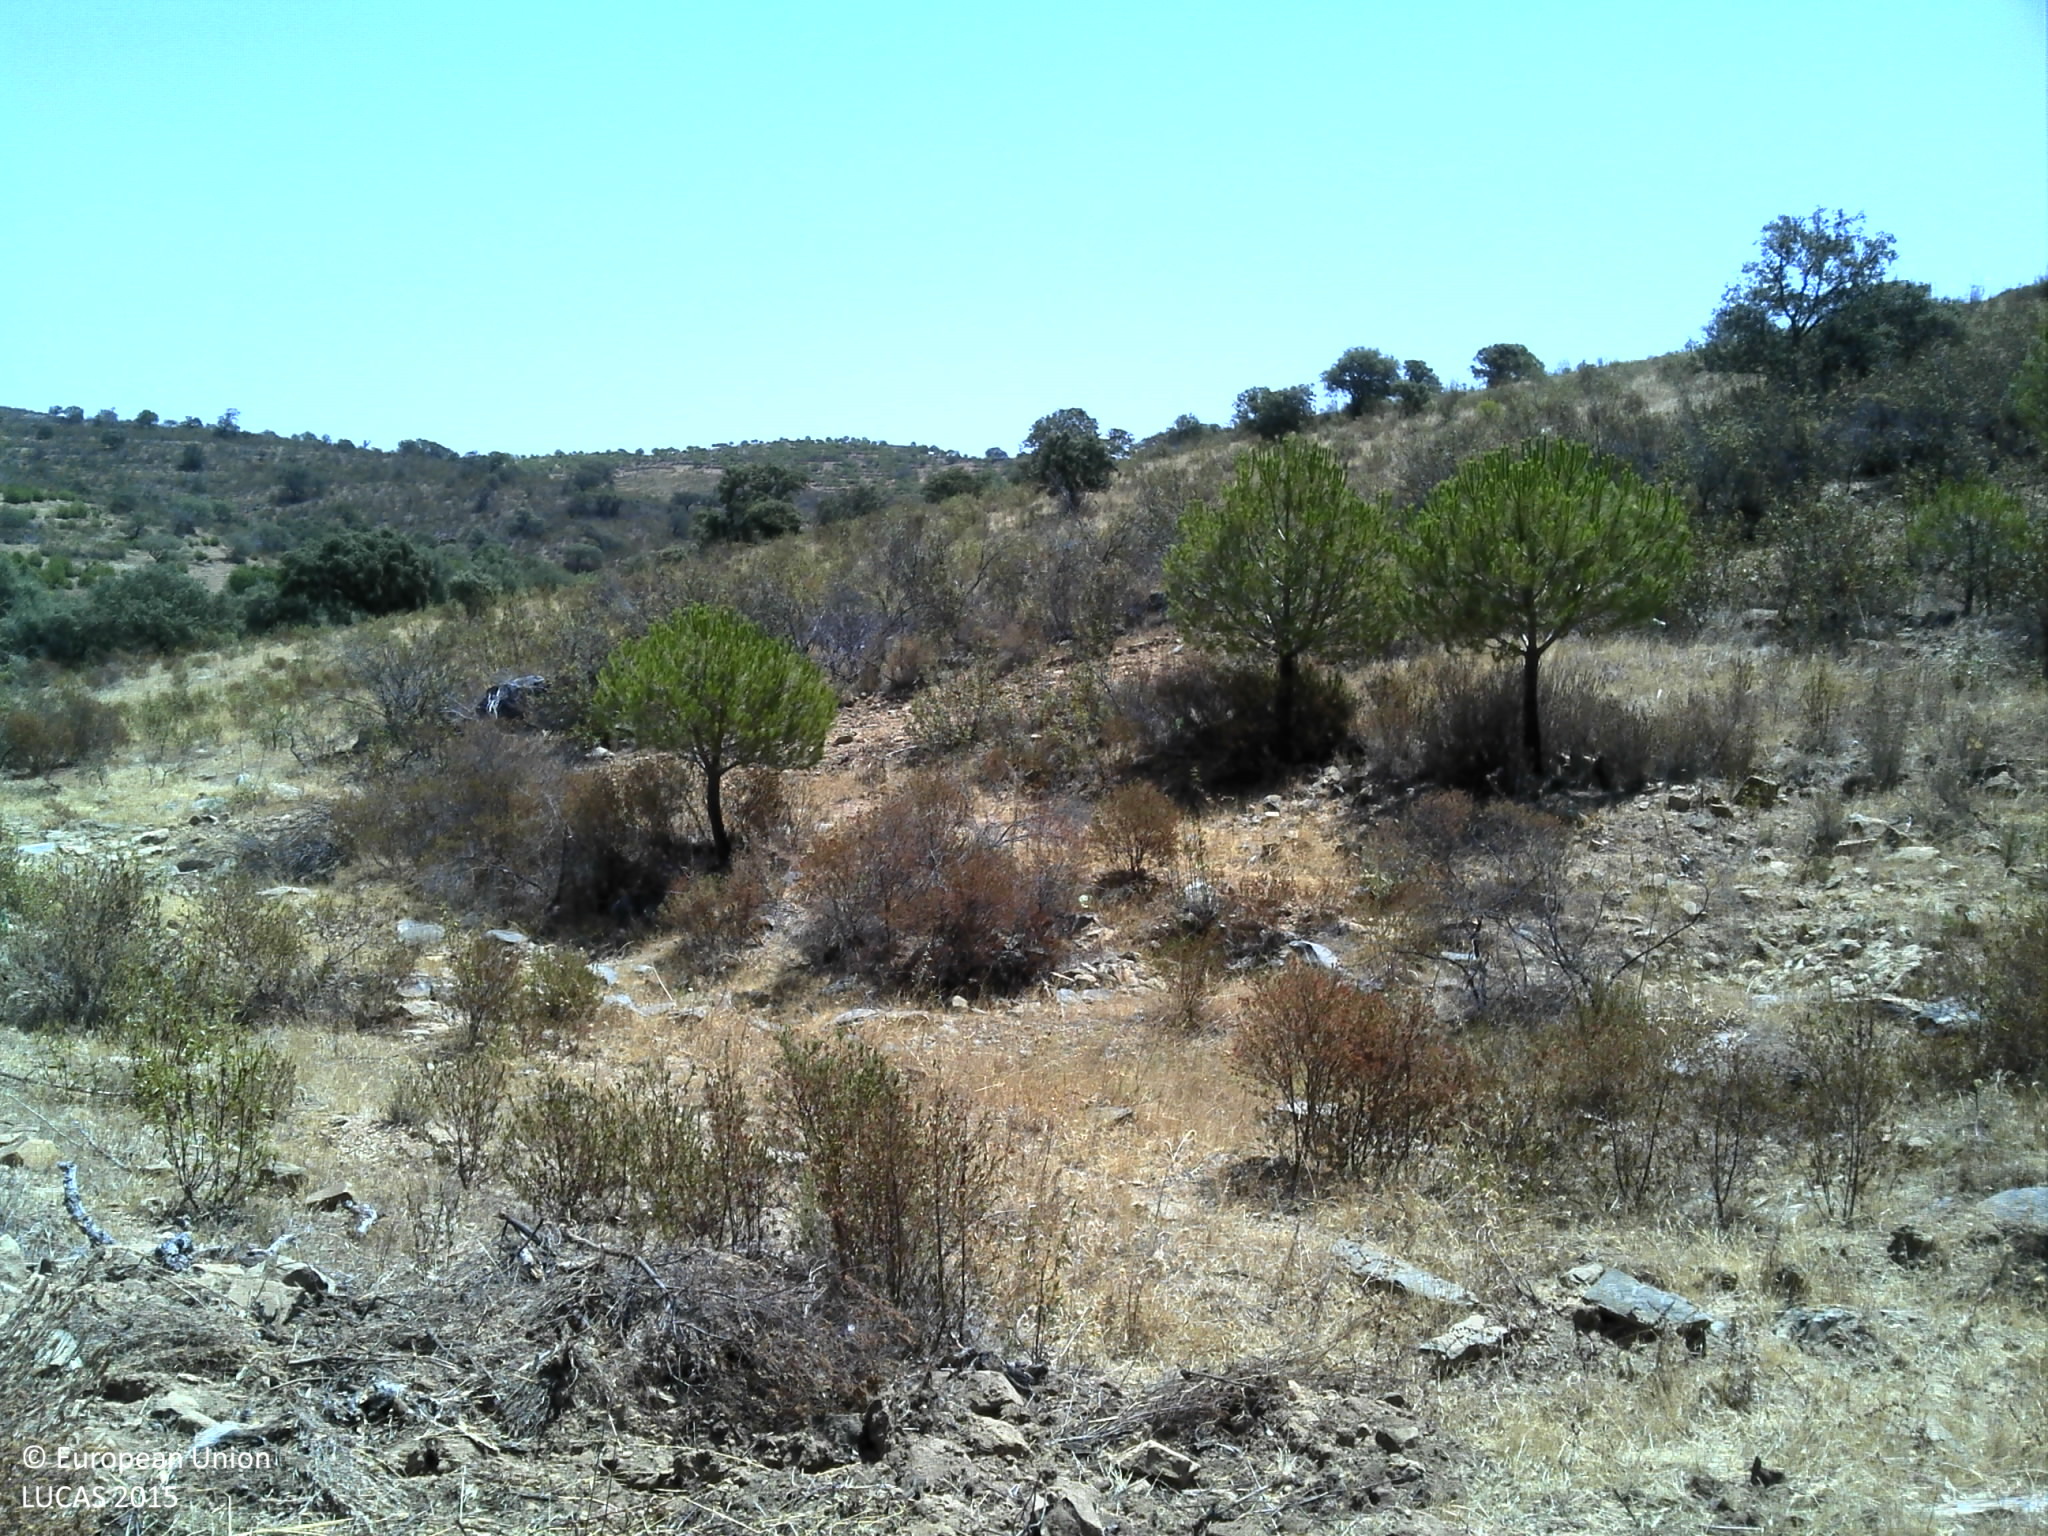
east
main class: Woodland
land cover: Pine dominated coniferous woodland
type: coniferous forest of the mediterranean region
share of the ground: 10 - 25 %
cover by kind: unconsolidated bare surface 55 %, coniferous forest trees 20 %, shrubs 20 %, herbaceous plants 5 %
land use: Forestry
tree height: < 5 m
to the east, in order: Pine dominated coniferous woodland; Rivers and streams; Pine dominated coniferous woodland; Other structural elements; Rock outcrops; Shrubland without tree cover; Single bushes/trees; Shrubland without tree cover; Single bushes/trees; Shrubland without tree cover; Shrubland with sparse tree cover; Shrubland without tree cover; Shrubland with sparse tree cover
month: July
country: PT
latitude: 37.4779
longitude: -7.8032
